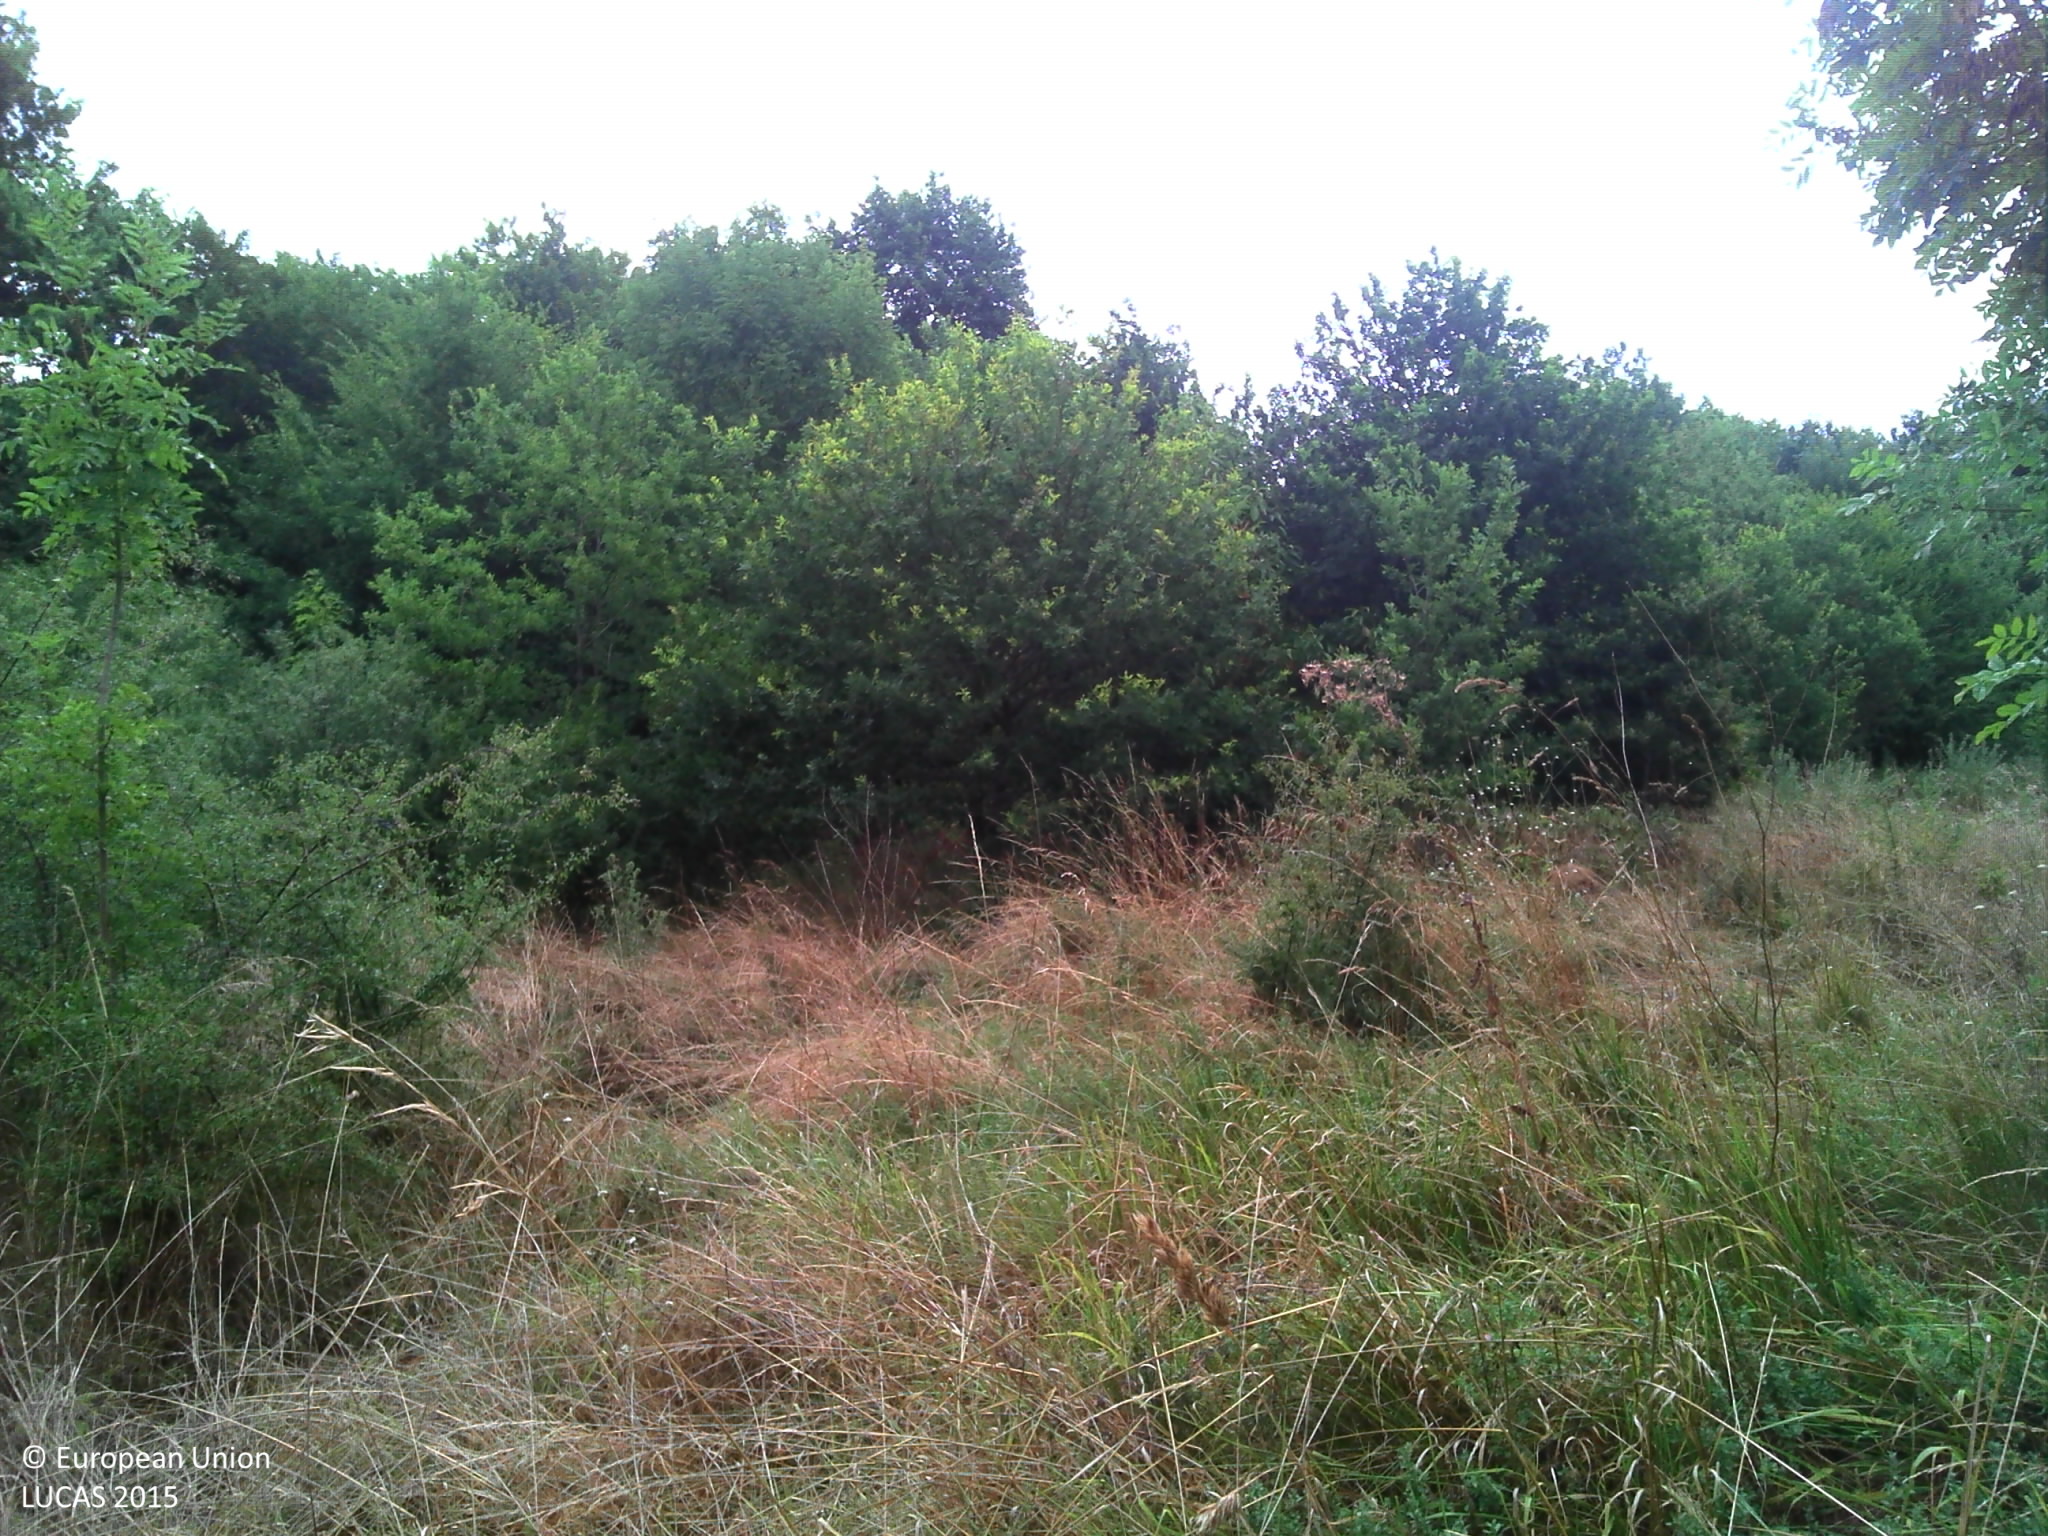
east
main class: Grassland
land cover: Grassland with sparse tree/shrub cover
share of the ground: > 75 %
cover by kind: herbaceous plants 80 %, shrubs 10 %, broadleaved forest trees 5 %, lichens and mosses 5 %
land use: Semi-natural and natural areas not in use
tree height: > 5 m
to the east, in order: Grassland with sparse tree/shrub cover; Fences; Grassland without tree/shrub cover; Fences; Grassland without tree/shrub cover
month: July
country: FR
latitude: 45.5756
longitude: 0.6199
